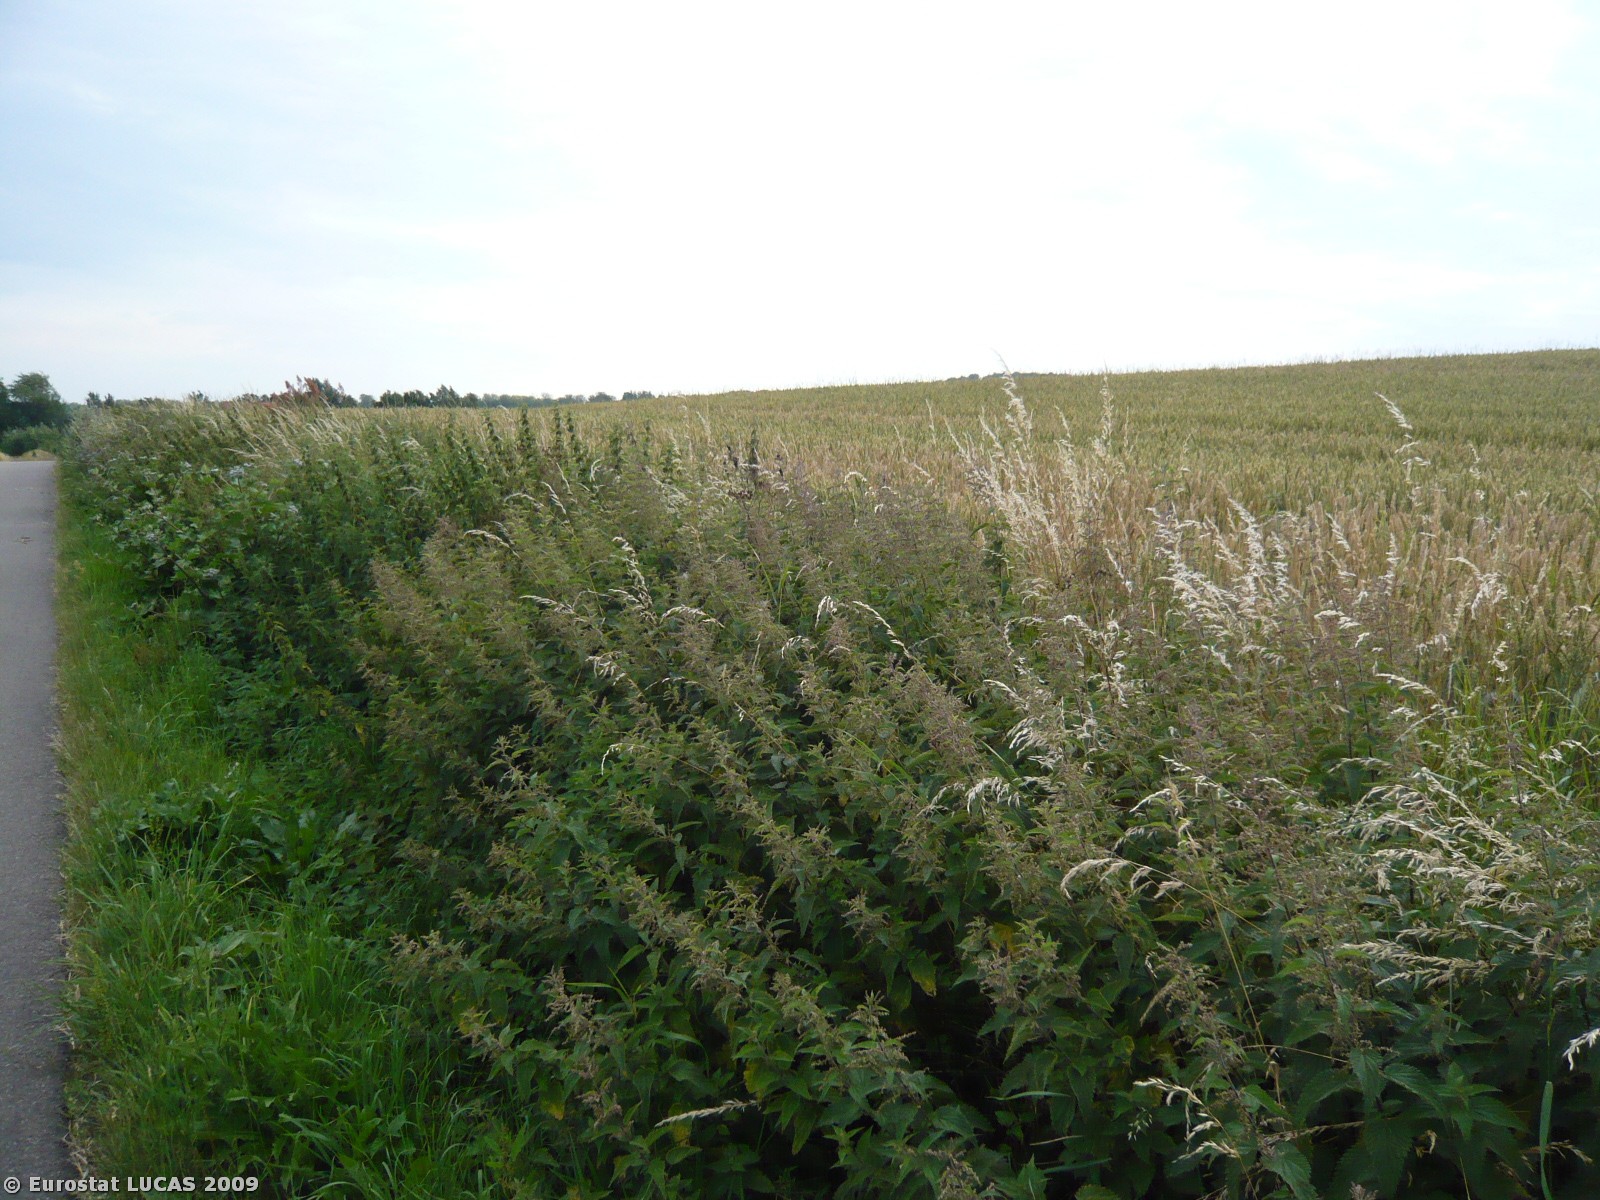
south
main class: Cropland
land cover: Common wheat
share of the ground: > 75 %
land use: Agriculture (excluding fallow land and kitchen gardens)
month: July
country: DK
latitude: 55.6945
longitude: 11.4146
